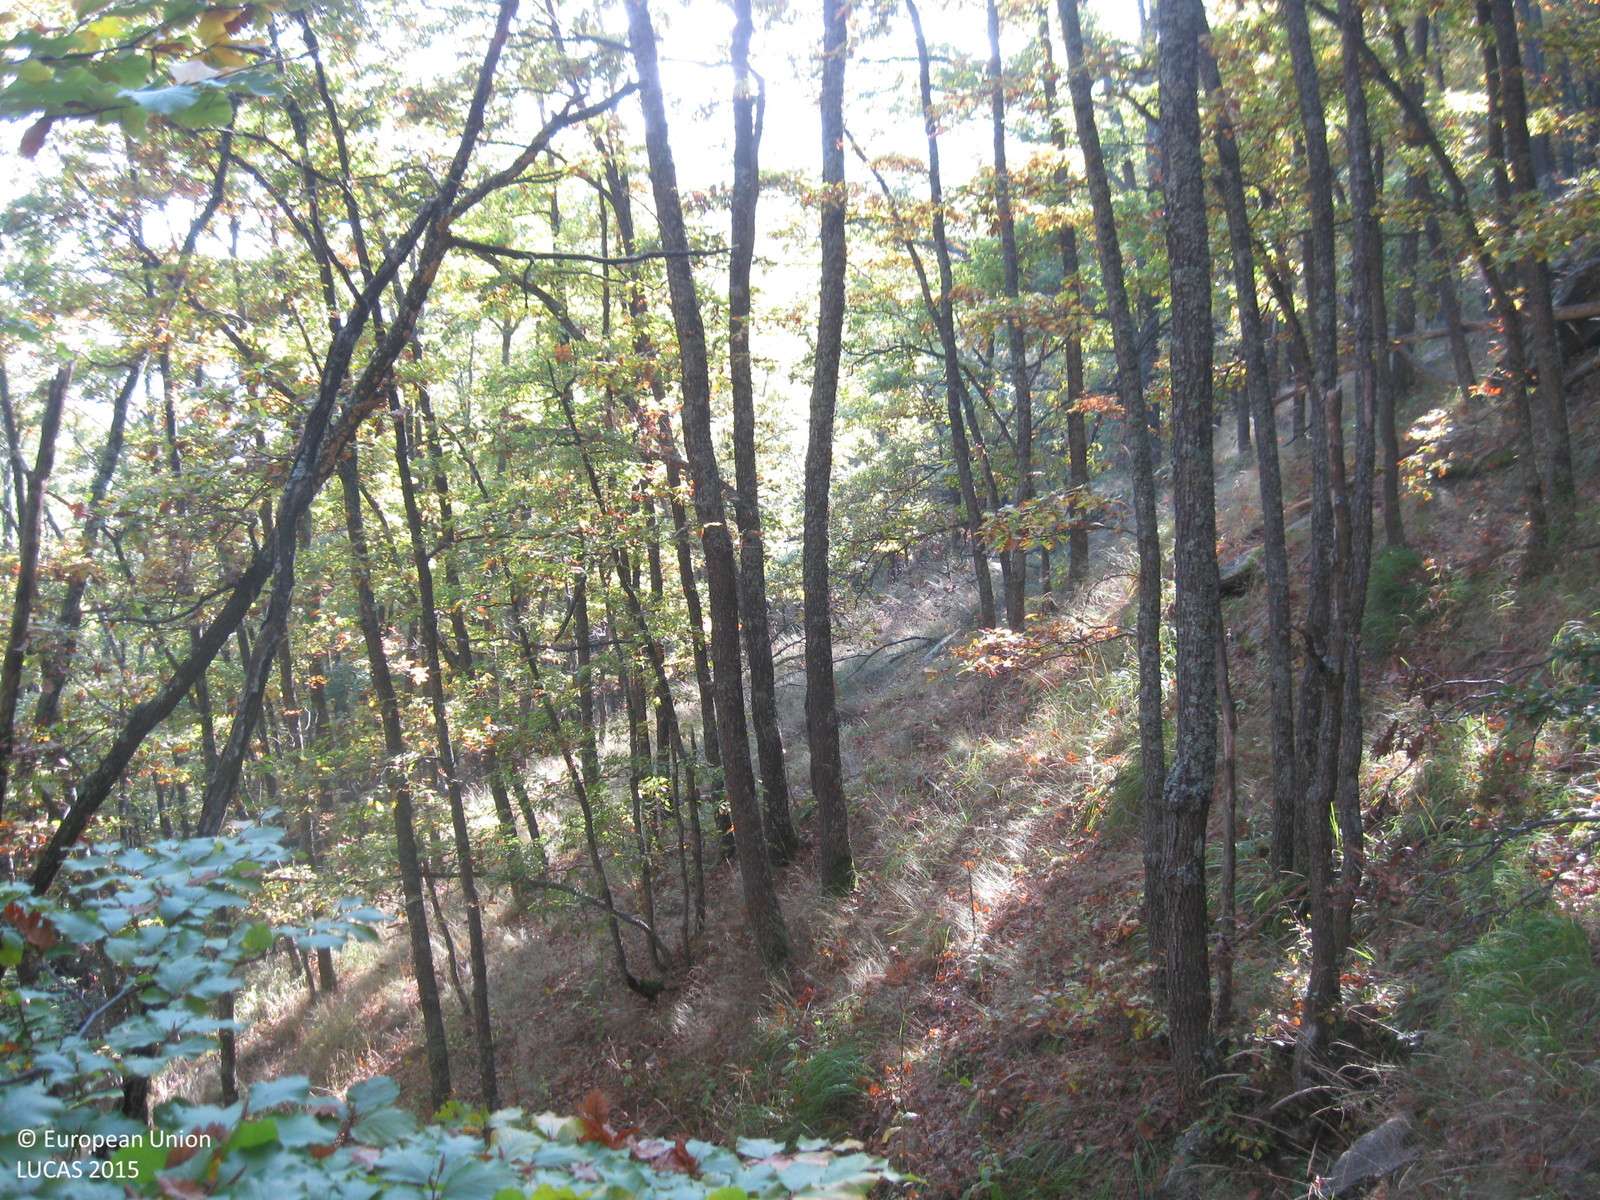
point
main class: Woodland
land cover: Broadleaved woodland
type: mesophytic deciduous forest
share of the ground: > 75 %
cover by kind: broadleaved forest trees 90 %, herbaceous plants 10 %
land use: Forestry
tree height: > 5 m
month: October
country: BG
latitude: 41.9338
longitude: 24.7505
